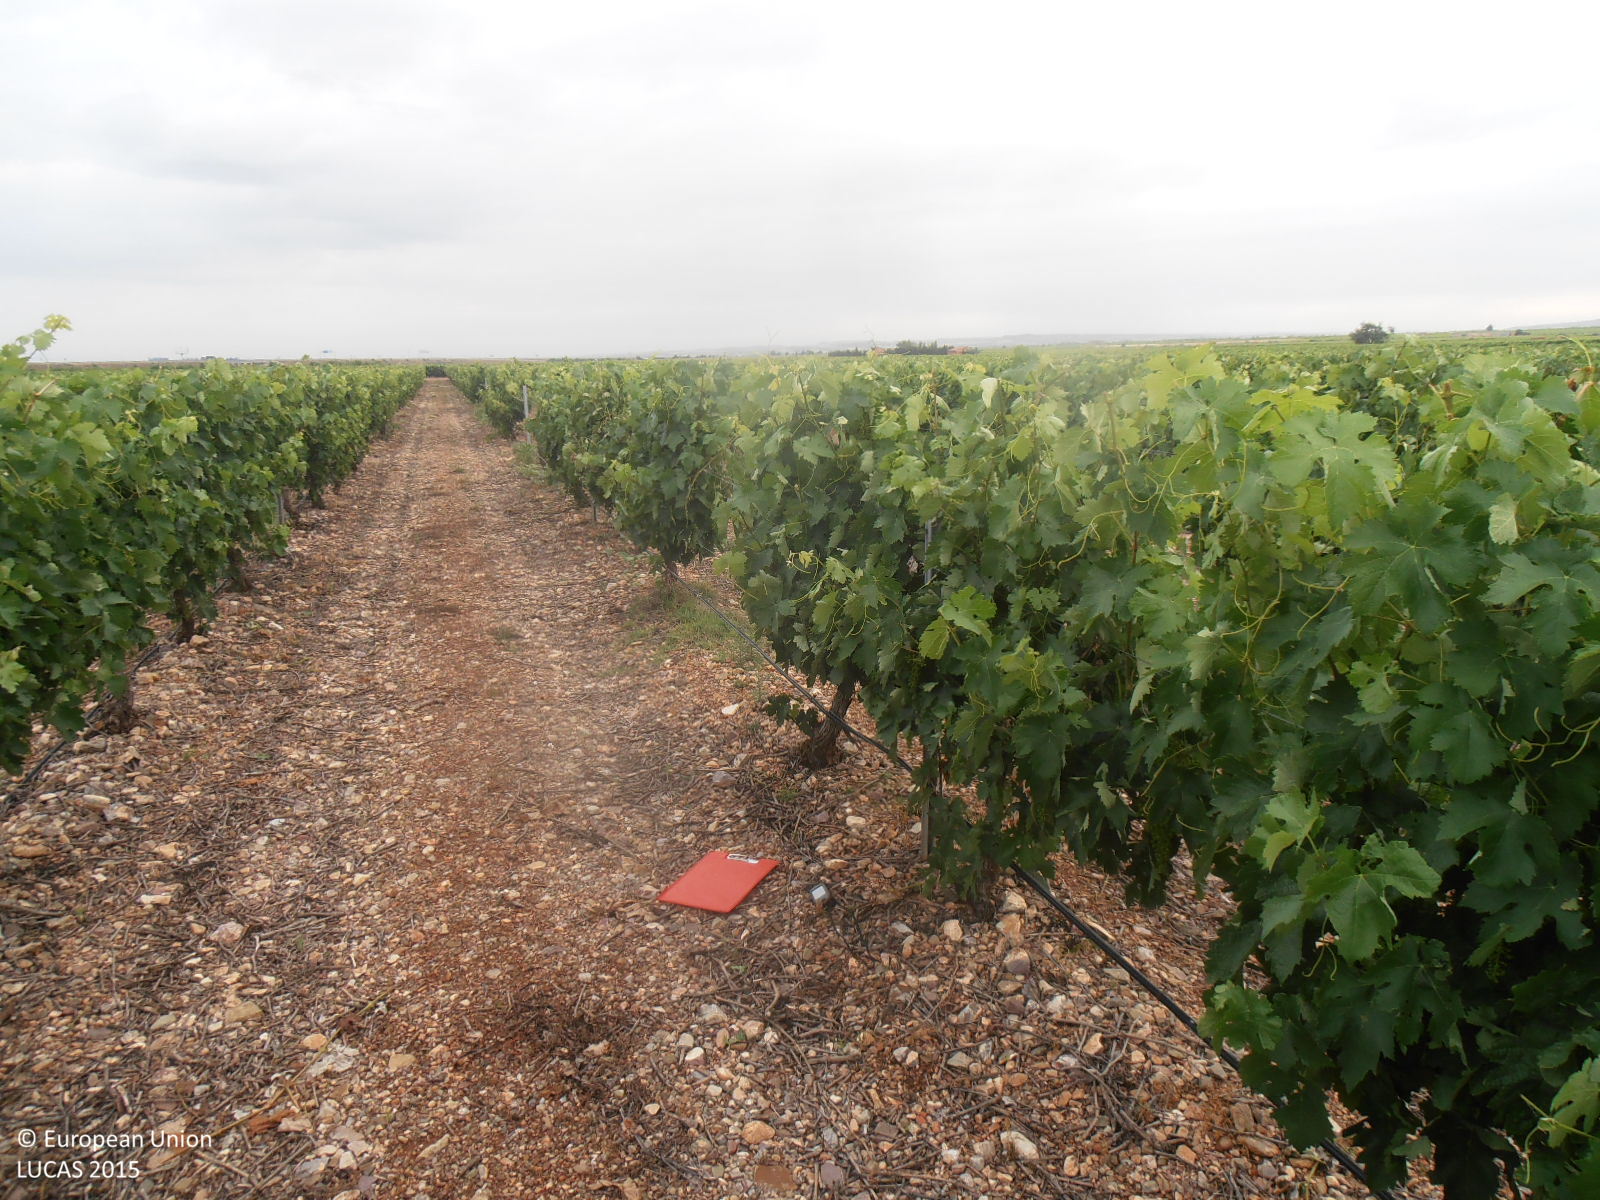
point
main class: Cropland
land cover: Vineyards
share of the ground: 10 - 25 %
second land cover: Other bare soil
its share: > 75 %
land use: Agriculture (excluding fallow land and kitchen gardens)
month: June
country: ES
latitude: 41.3569
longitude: -1.1977
